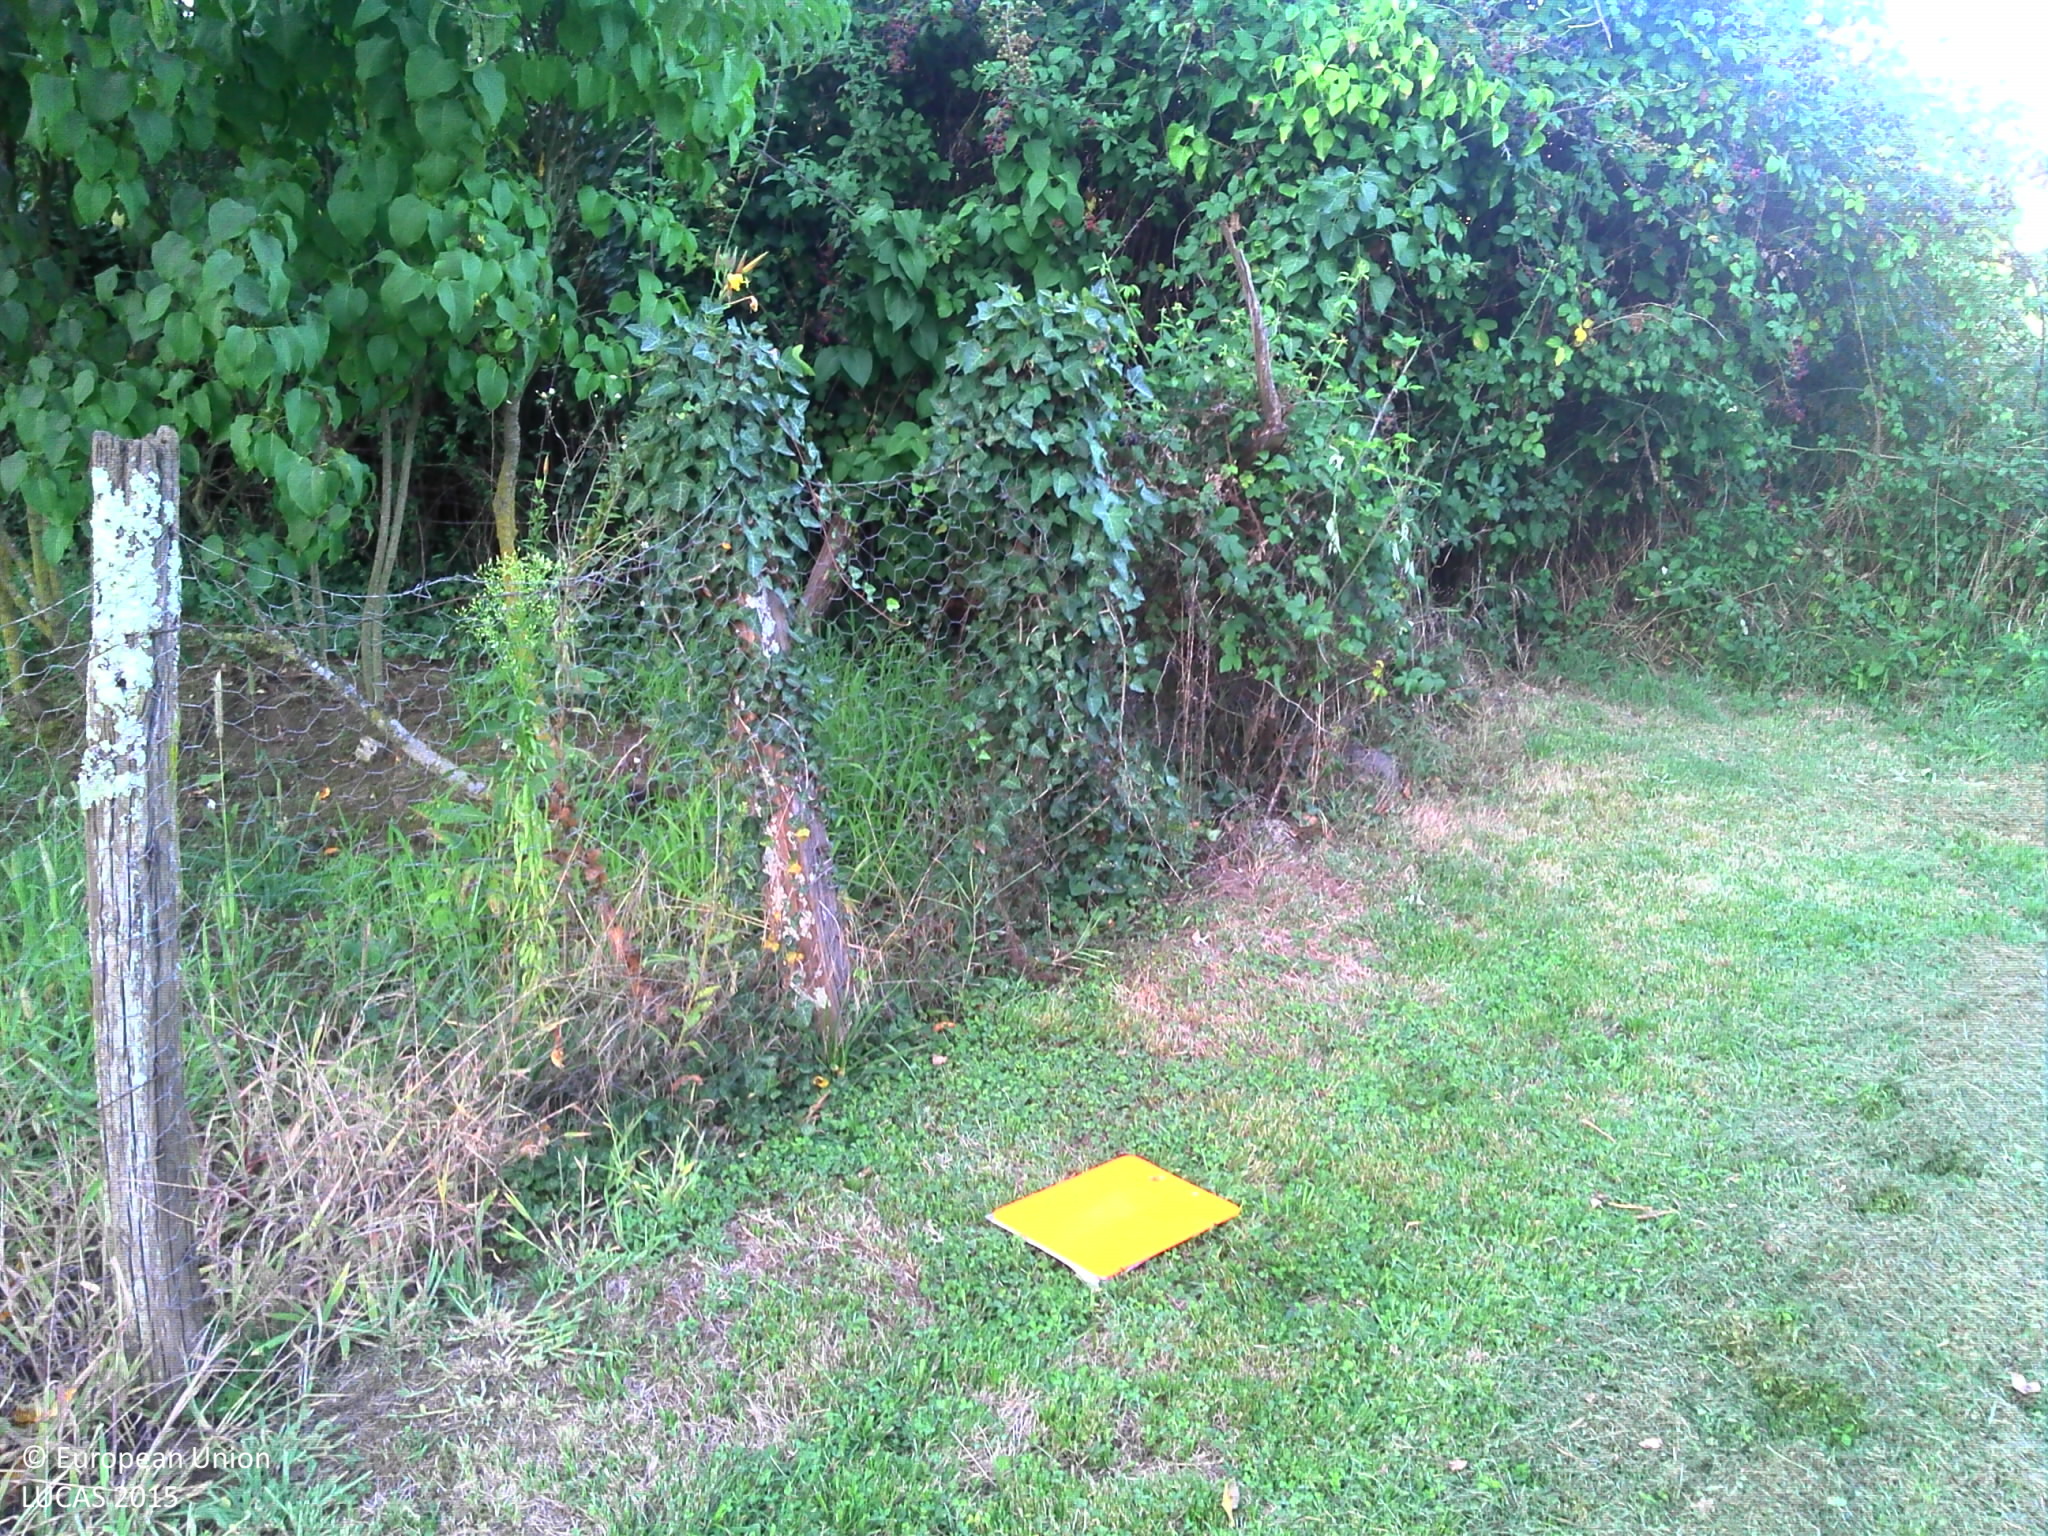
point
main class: Cropland
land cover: Other fruit trees and berries
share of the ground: 25 - 50 %
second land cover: Grassland without tree/shrub cover
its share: 50 - 75 %
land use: Kitchen garden
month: August
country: FR
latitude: 45.1311
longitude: 0.5164
